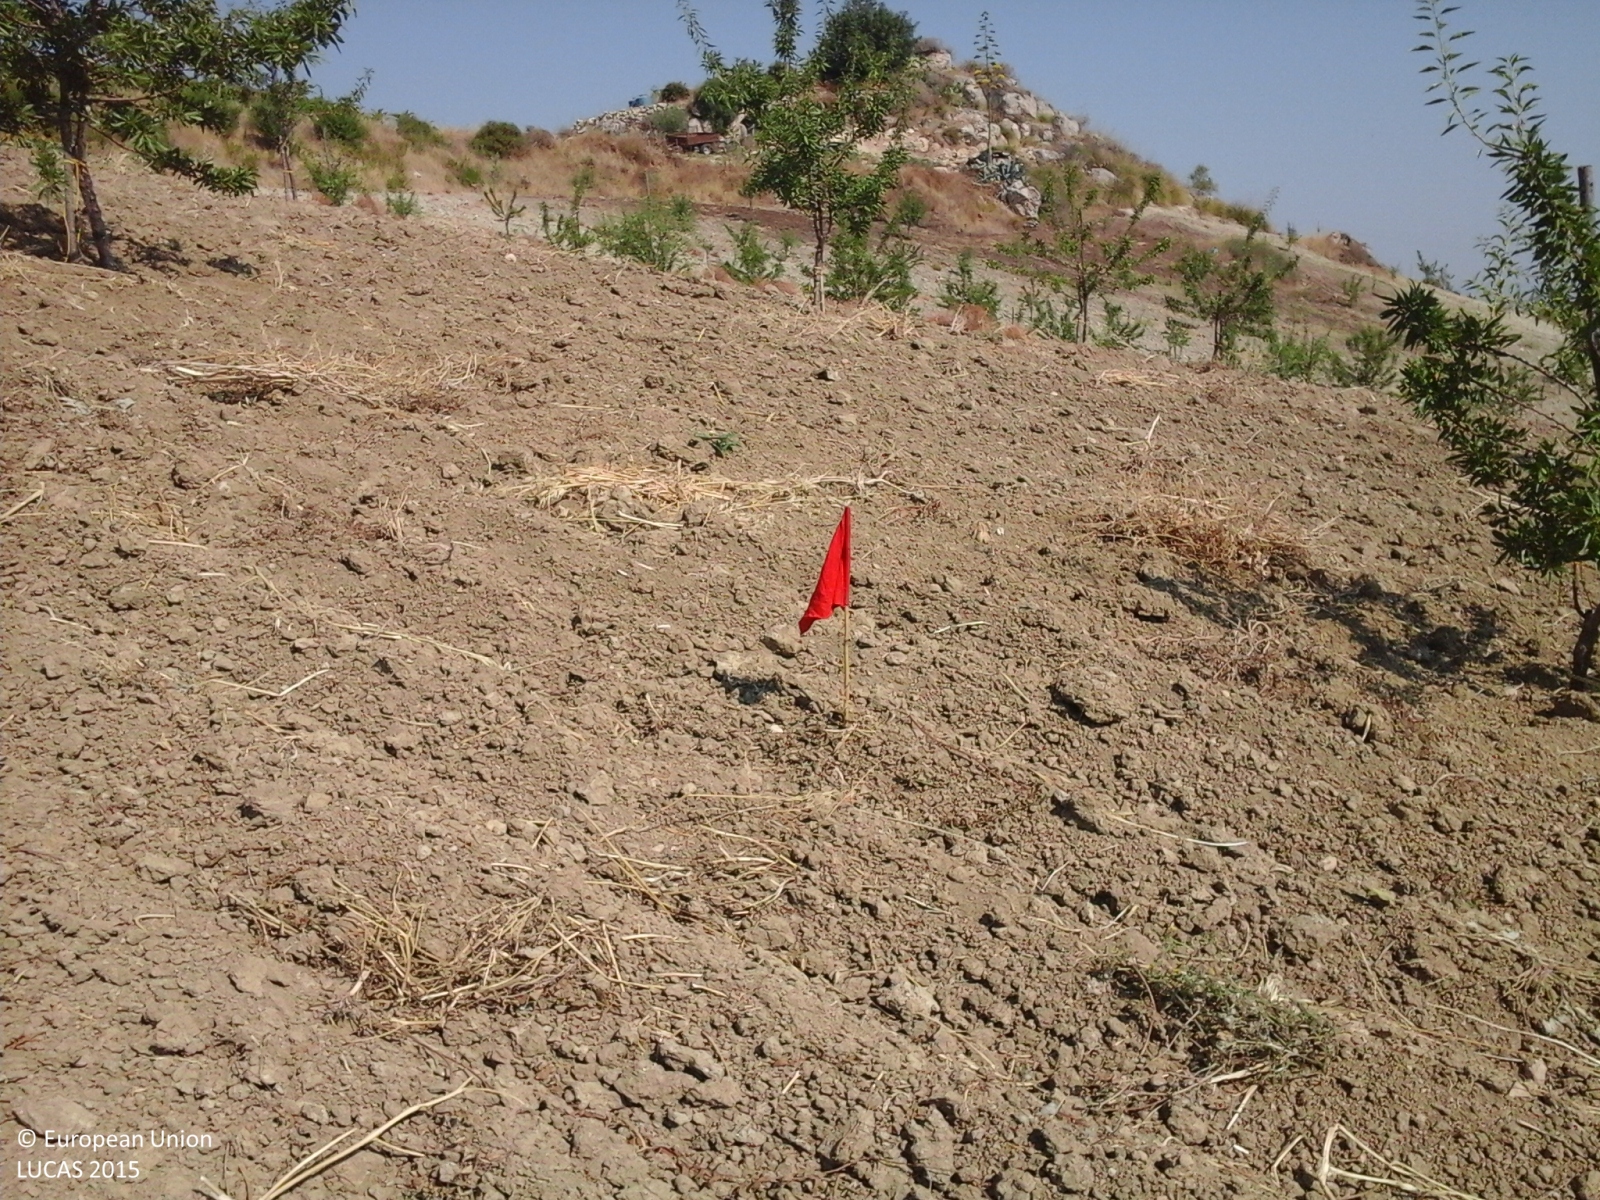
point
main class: Cropland
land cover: Nuts trees
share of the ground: > 75 %
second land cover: Other bare soil
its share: > 75 %
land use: Agriculture (excluding fallow land and kitchen gardens)
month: July
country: IT
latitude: 37.2771
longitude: 14.1074
